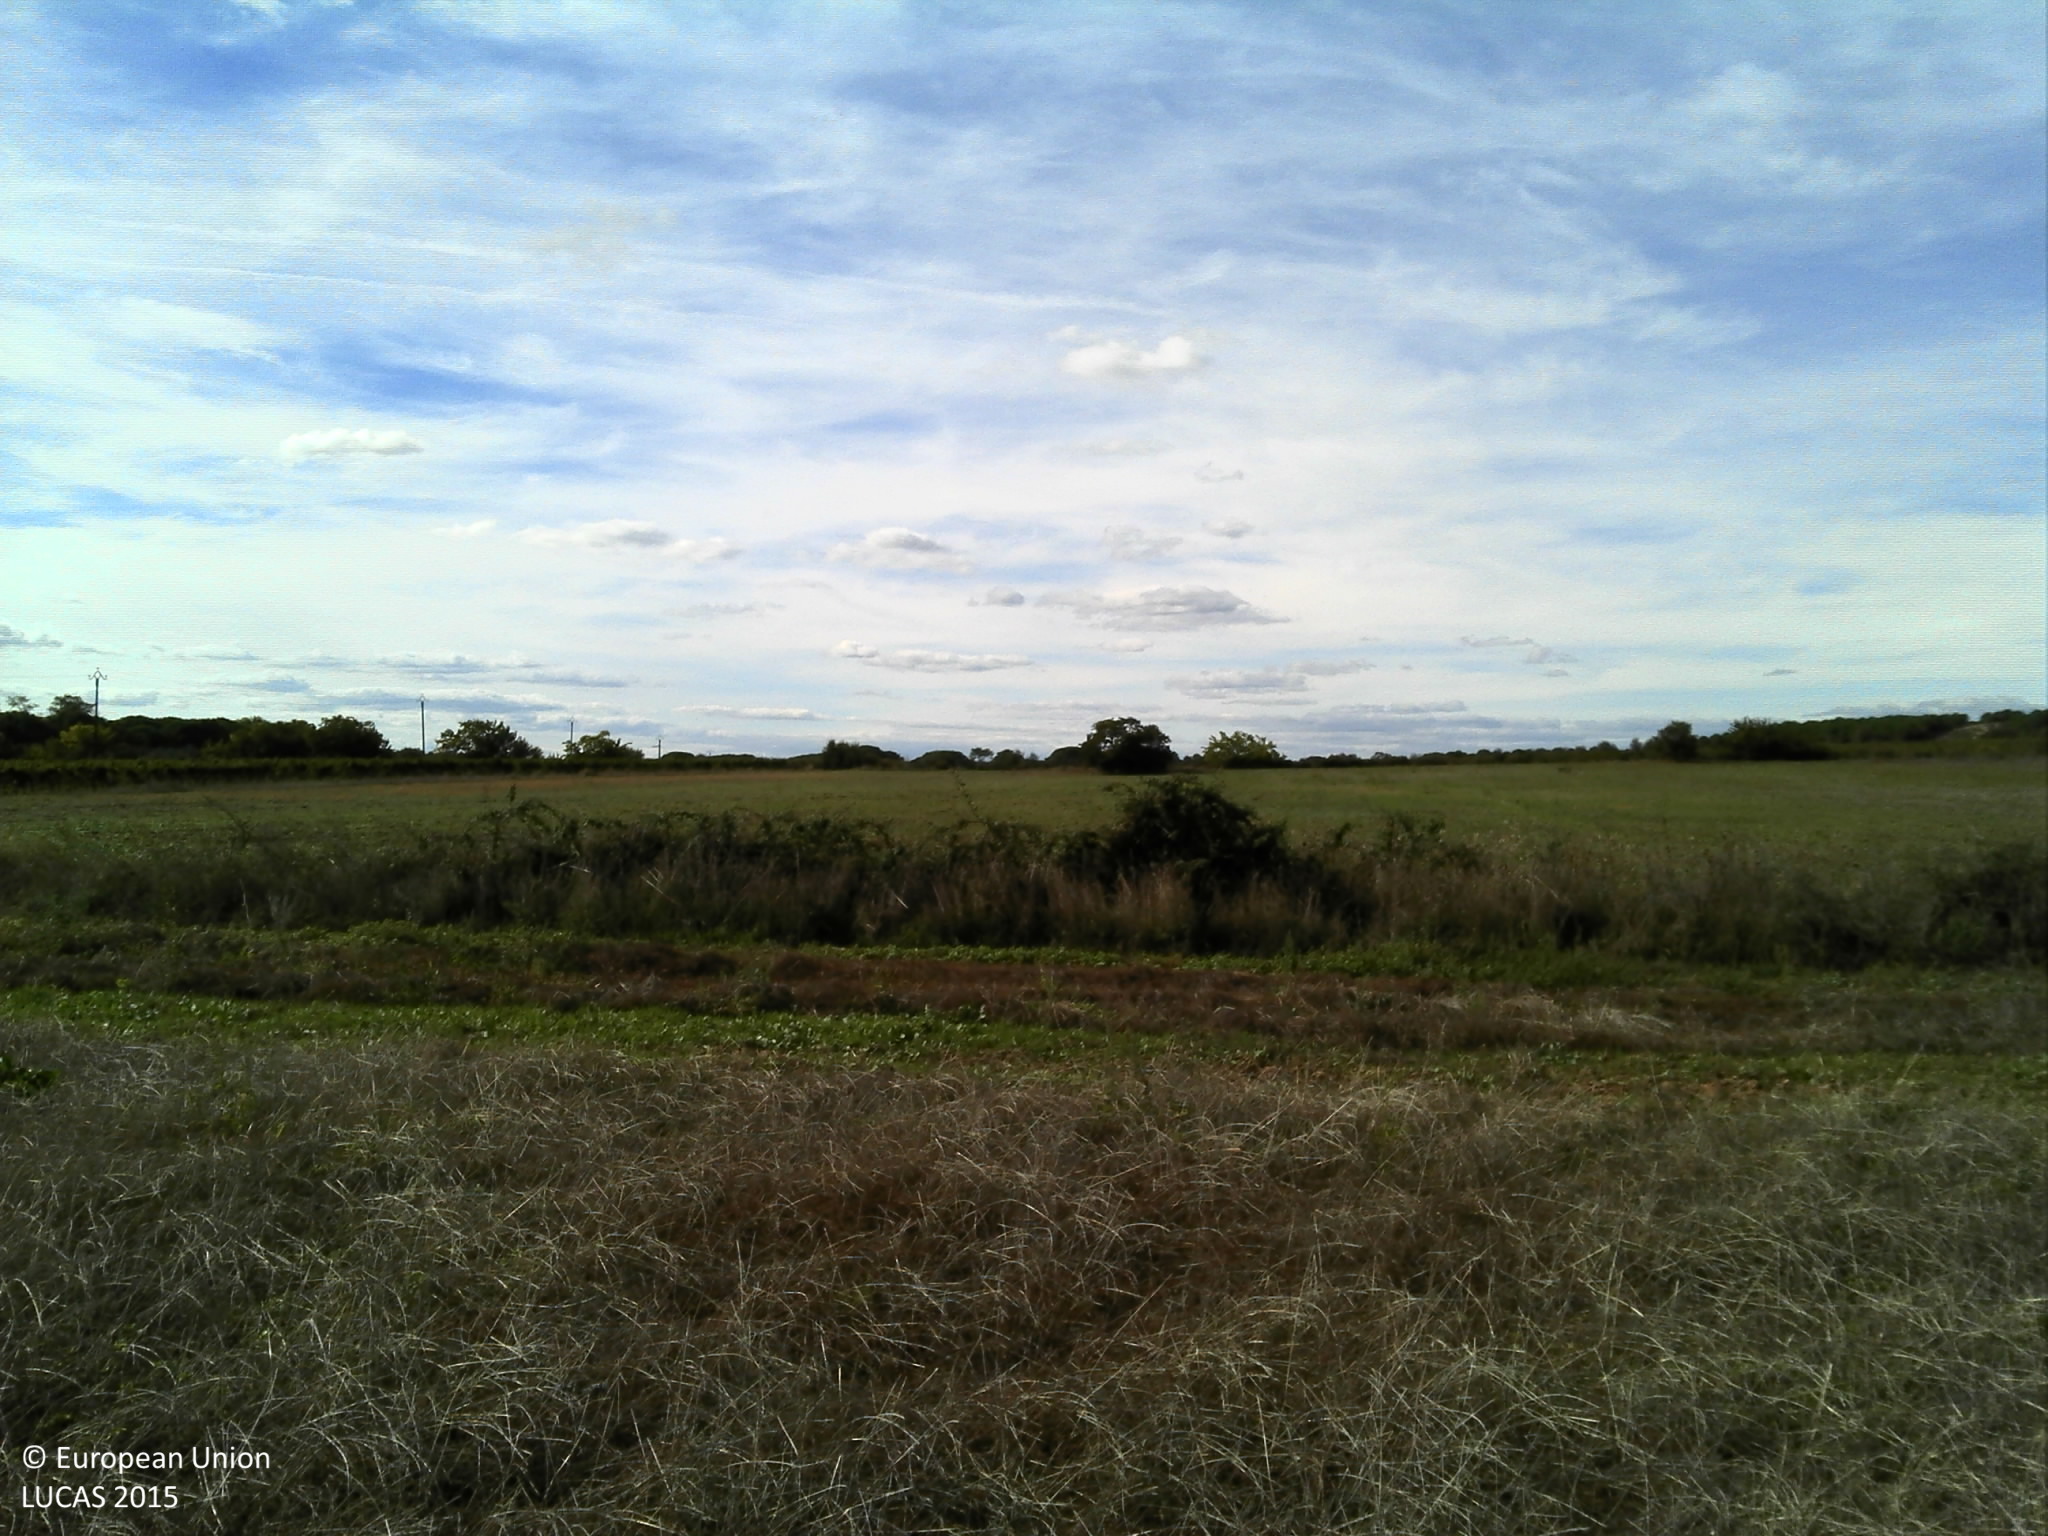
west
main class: Grassland
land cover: Spontaneously vegetated surfaces
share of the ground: > 75 %
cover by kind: herbaceous plants 95 %, unconsolidated bare surface 5 %
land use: Fallow land
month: October
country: FR
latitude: 43.3431
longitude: 3.3855
